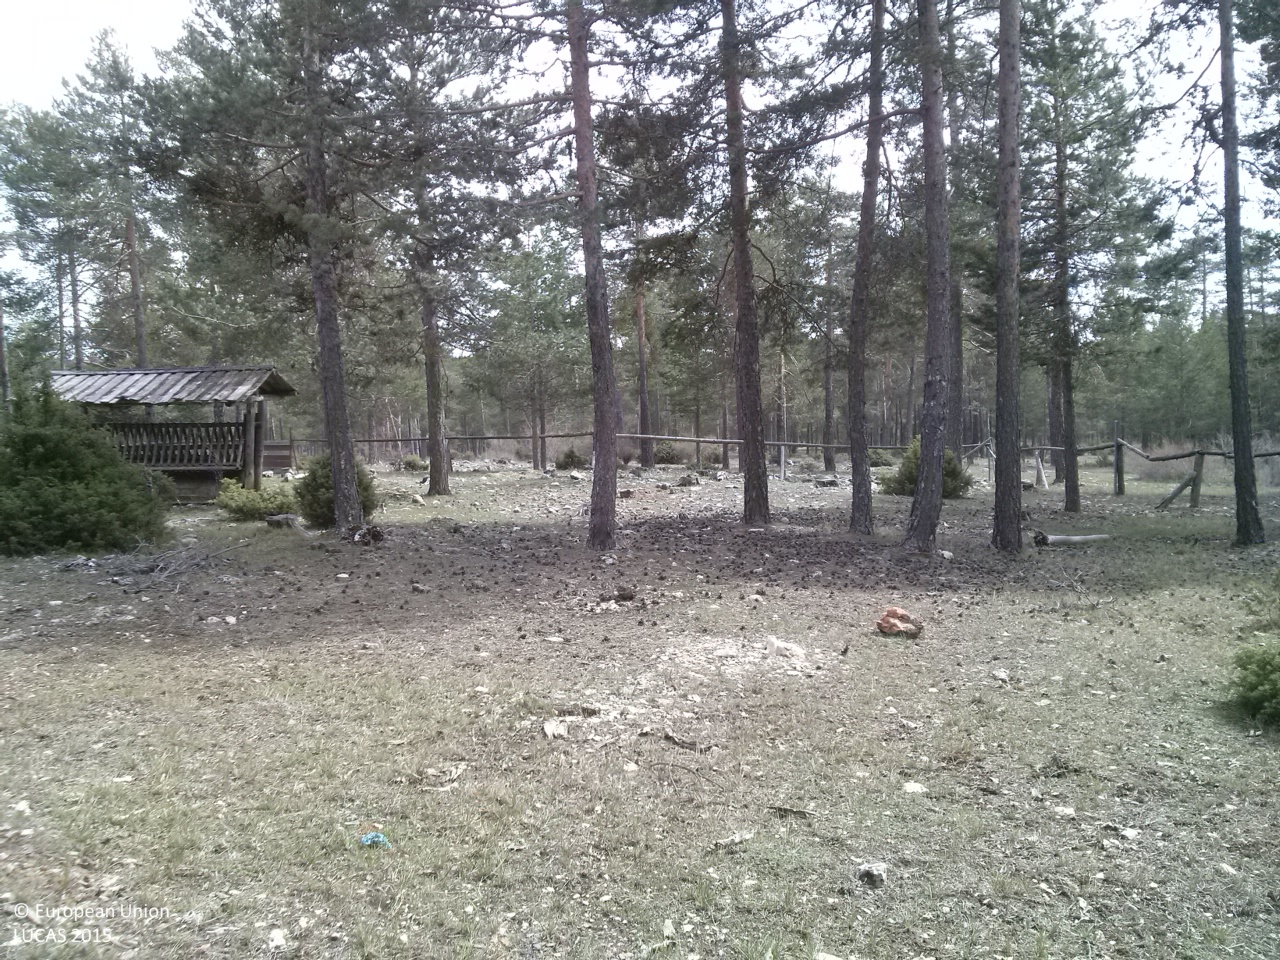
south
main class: Woodland
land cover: Pine dominated coniferous woodland
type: coniferous forest of the mediterranean region
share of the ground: 50 - 75 %
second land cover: Grassland without tree/shrub cover
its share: > 75 %
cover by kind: coniferous forest trees 50 %, herbaceous plants 50 %
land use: Forestry
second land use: Agriculture (excluding fallow land and kitchen gardens)
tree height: > 5 m
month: April
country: ES
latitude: 40.2882
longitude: -1.9085
